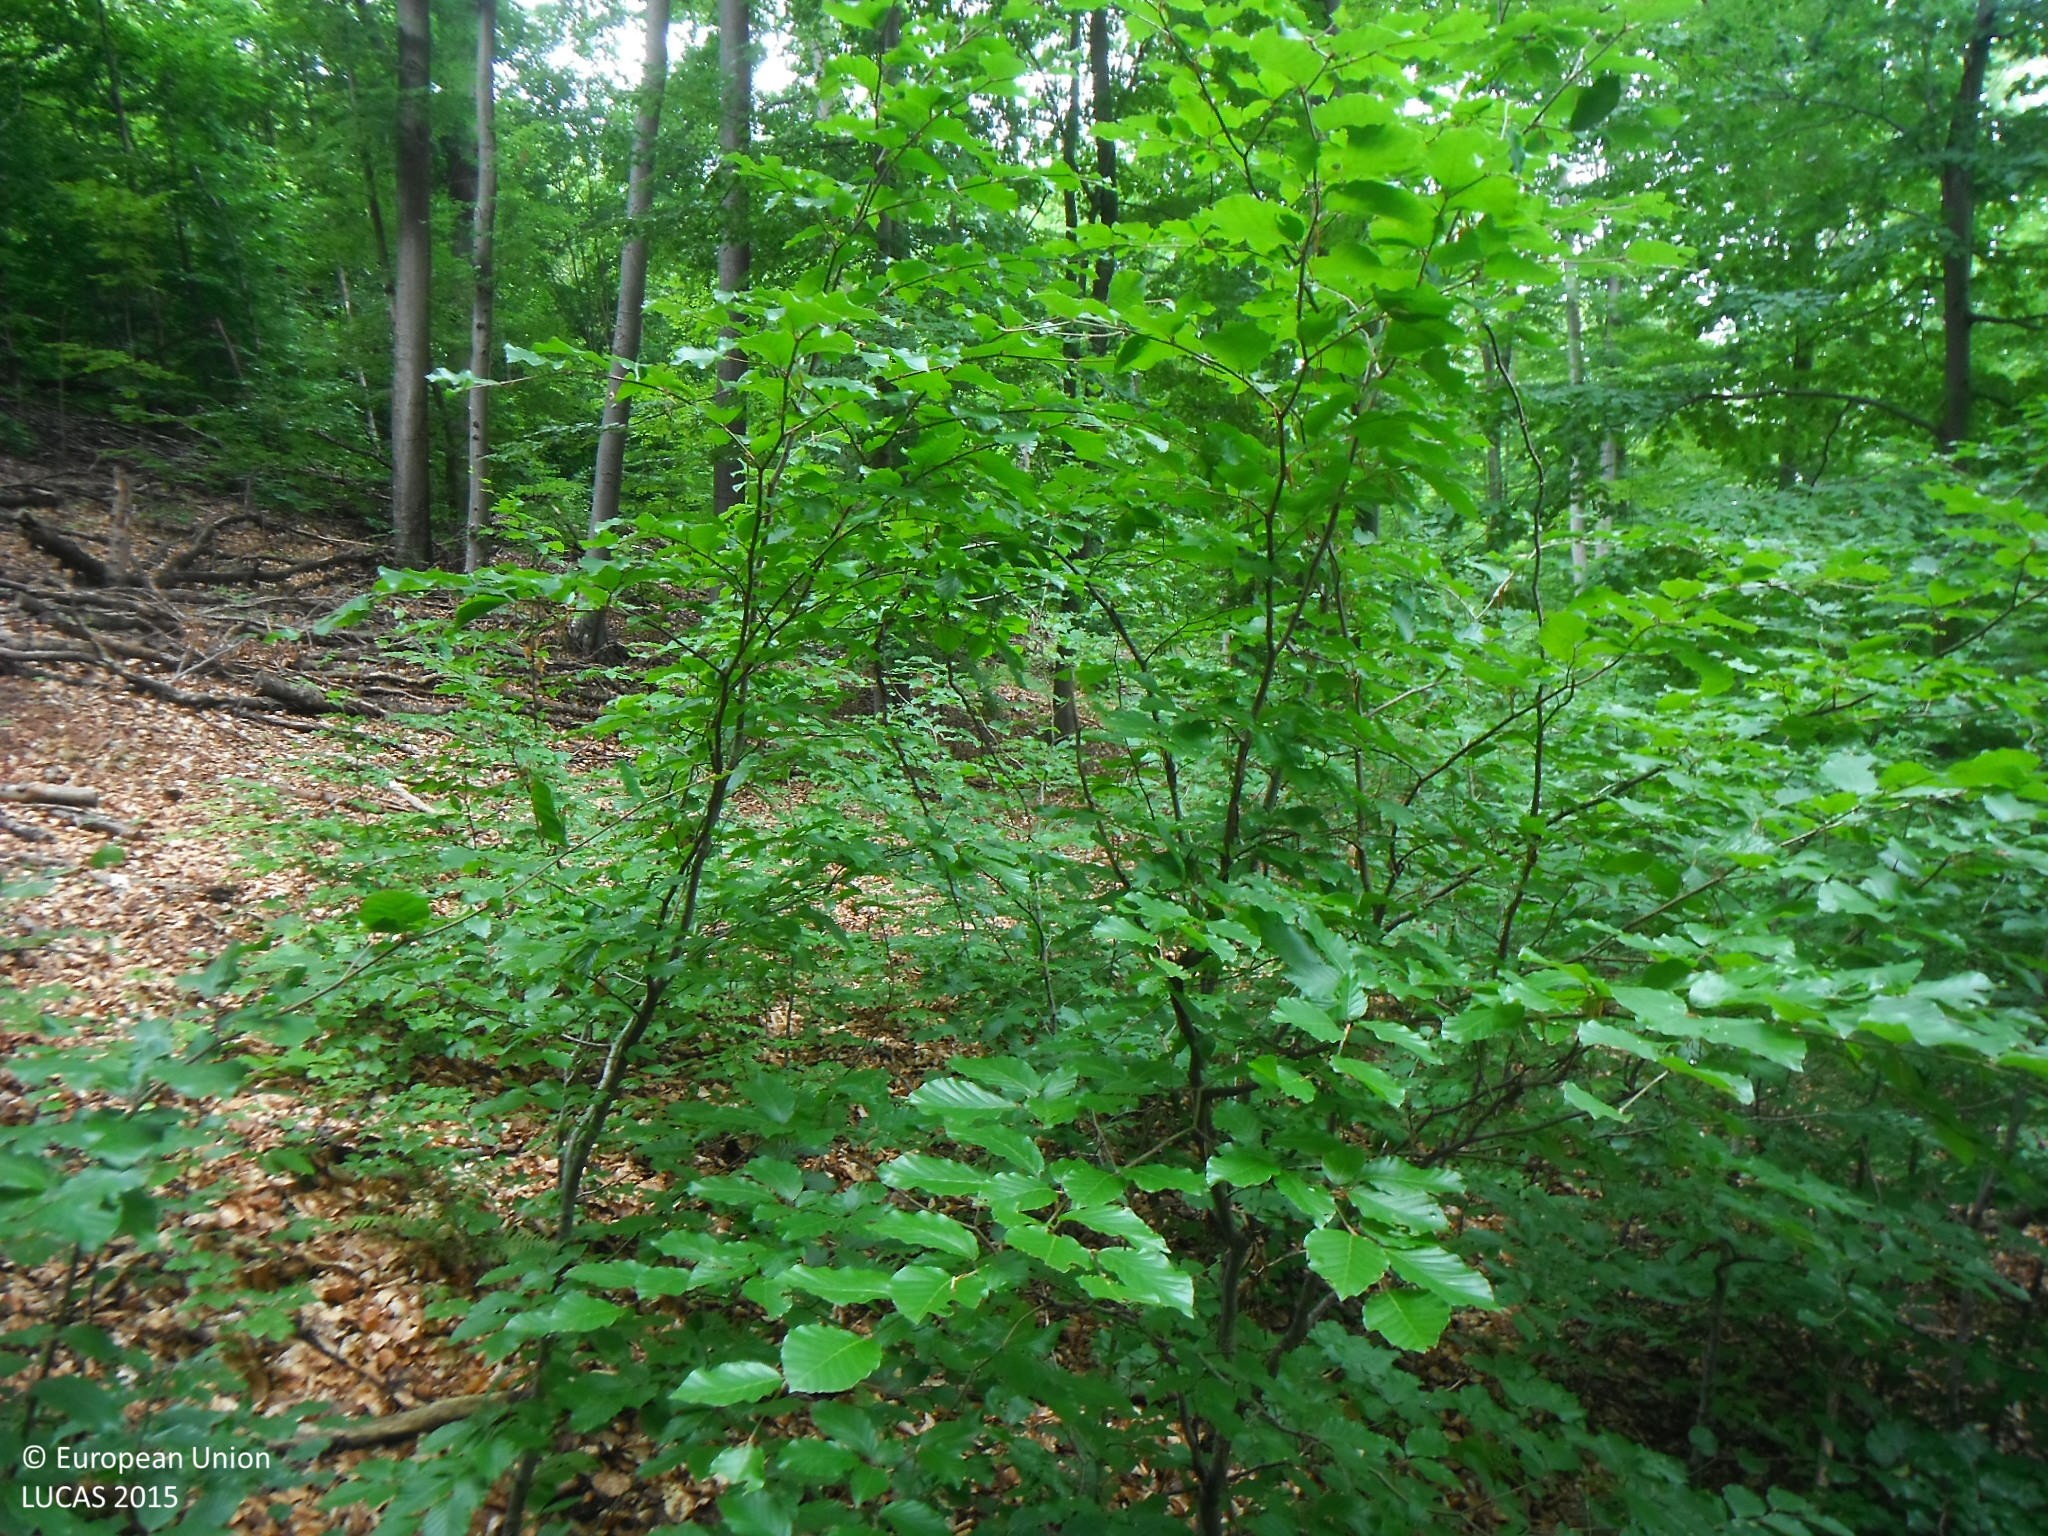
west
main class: Woodland
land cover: Broadleaved woodland
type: beech forest
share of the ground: > 75 %
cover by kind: broadleaved forest trees 80 %, herbaceous plants 15 %, lichens and mosses 5 %
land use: Forestry
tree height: > 5 m
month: June
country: SK
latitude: 49.0565
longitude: 22.0021
